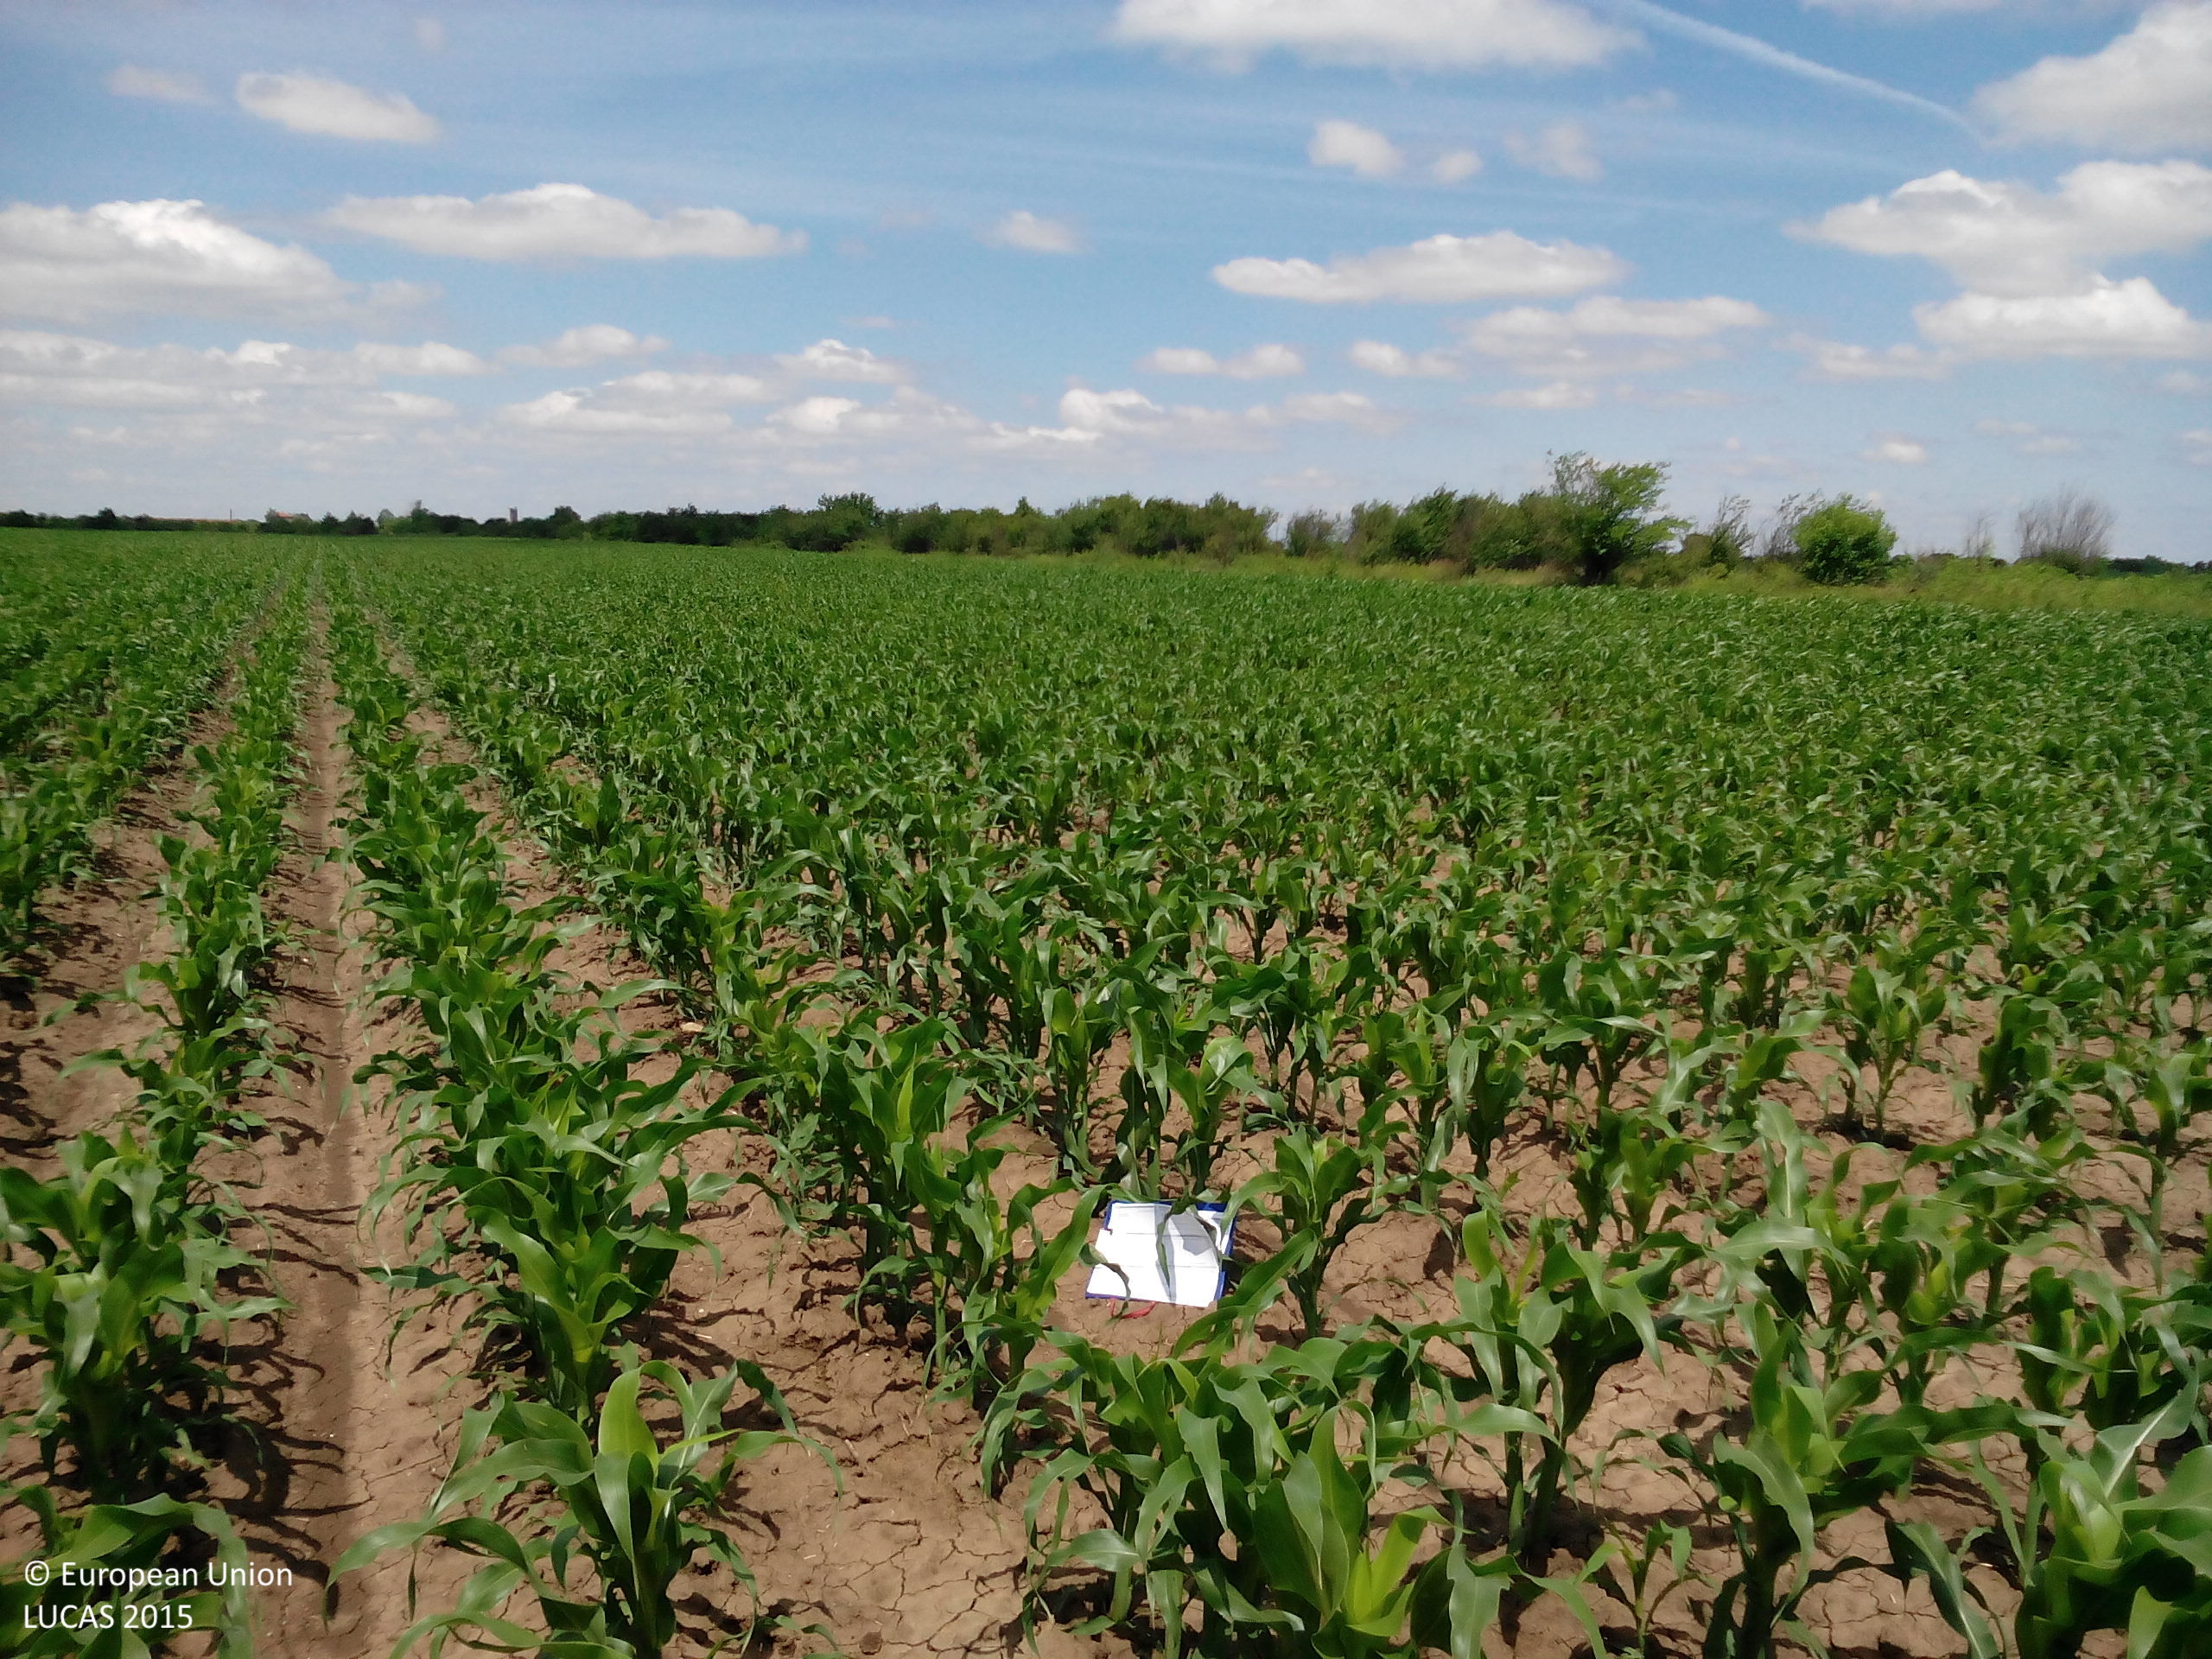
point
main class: Cropland
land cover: Maize
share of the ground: 50 - 75 %
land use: Agriculture (excluding fallow land and kitchen gardens)
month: May
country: BG
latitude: 43.4900
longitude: 24.1141
